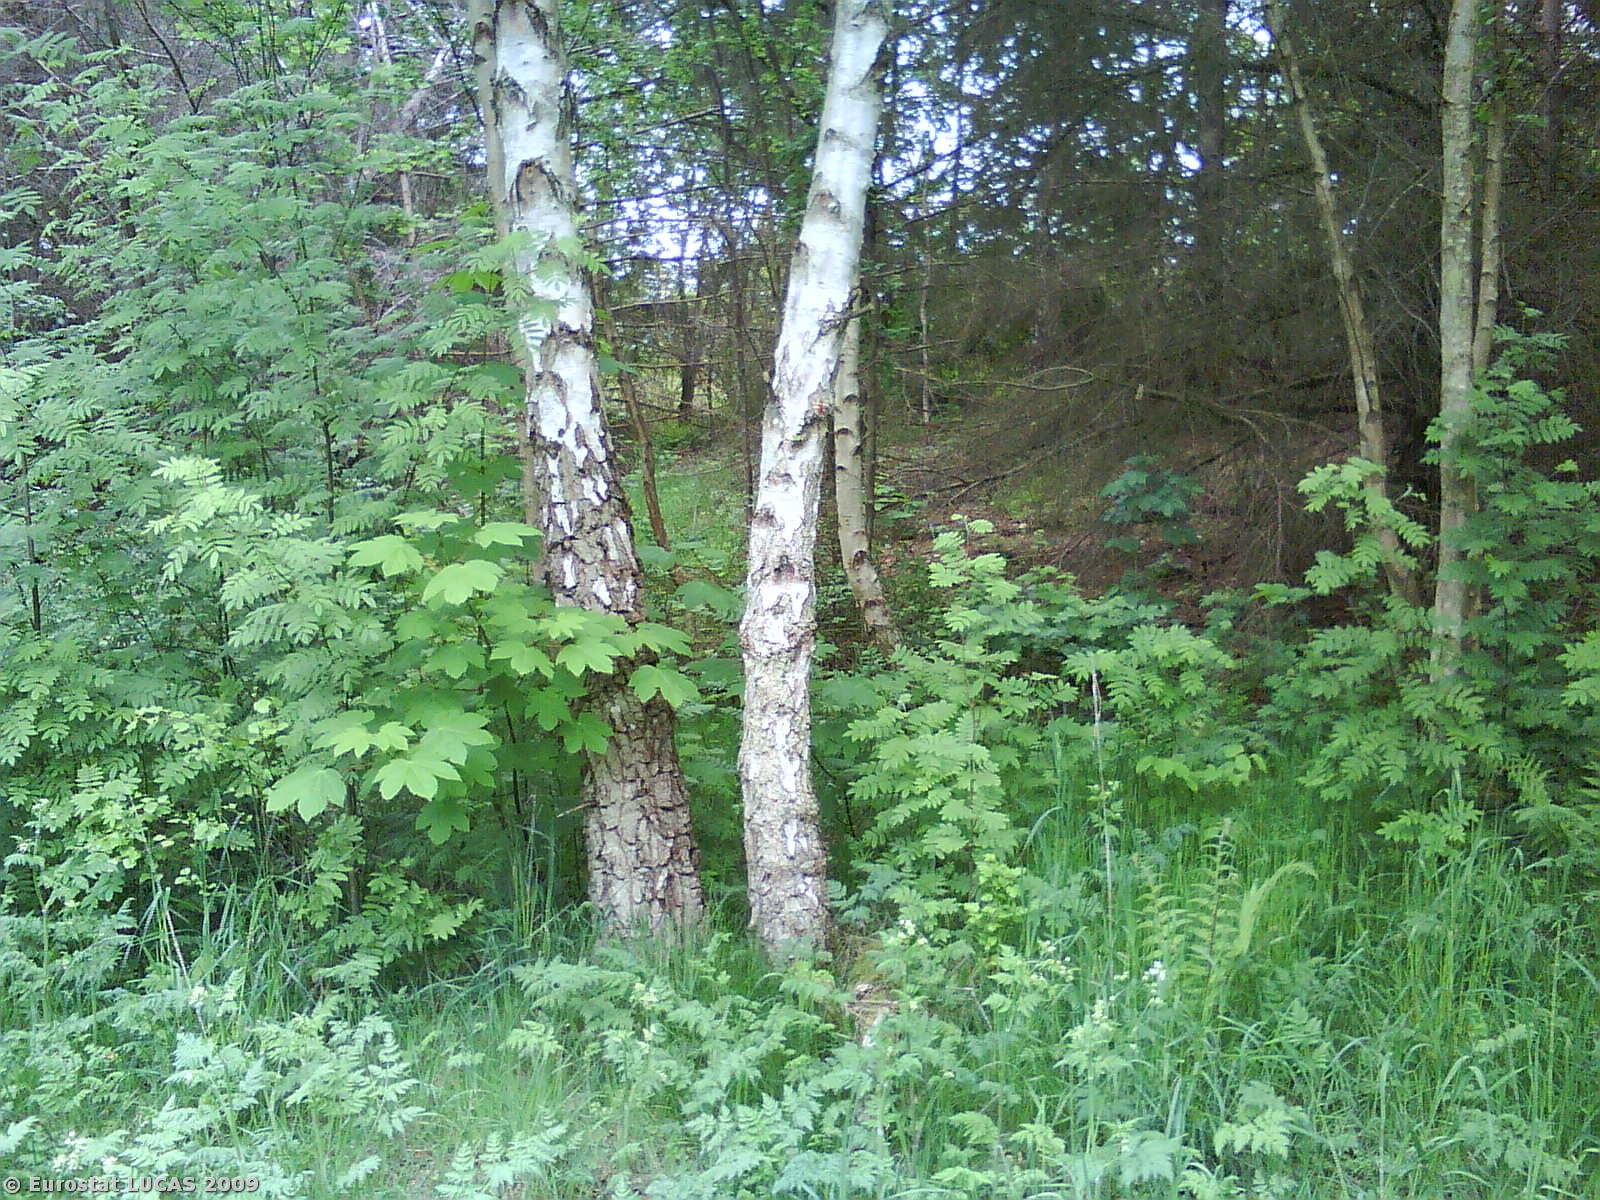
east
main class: Woodland
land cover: Broadleaved woodland
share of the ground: > 75 %
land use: Unused
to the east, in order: Broadleaved woodland; Mixed woodland; Shrubland with sparse tree cover; Tracks; Shrubland with sparse tree cover
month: May
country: DK
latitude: 56.5272
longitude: 10.7306
